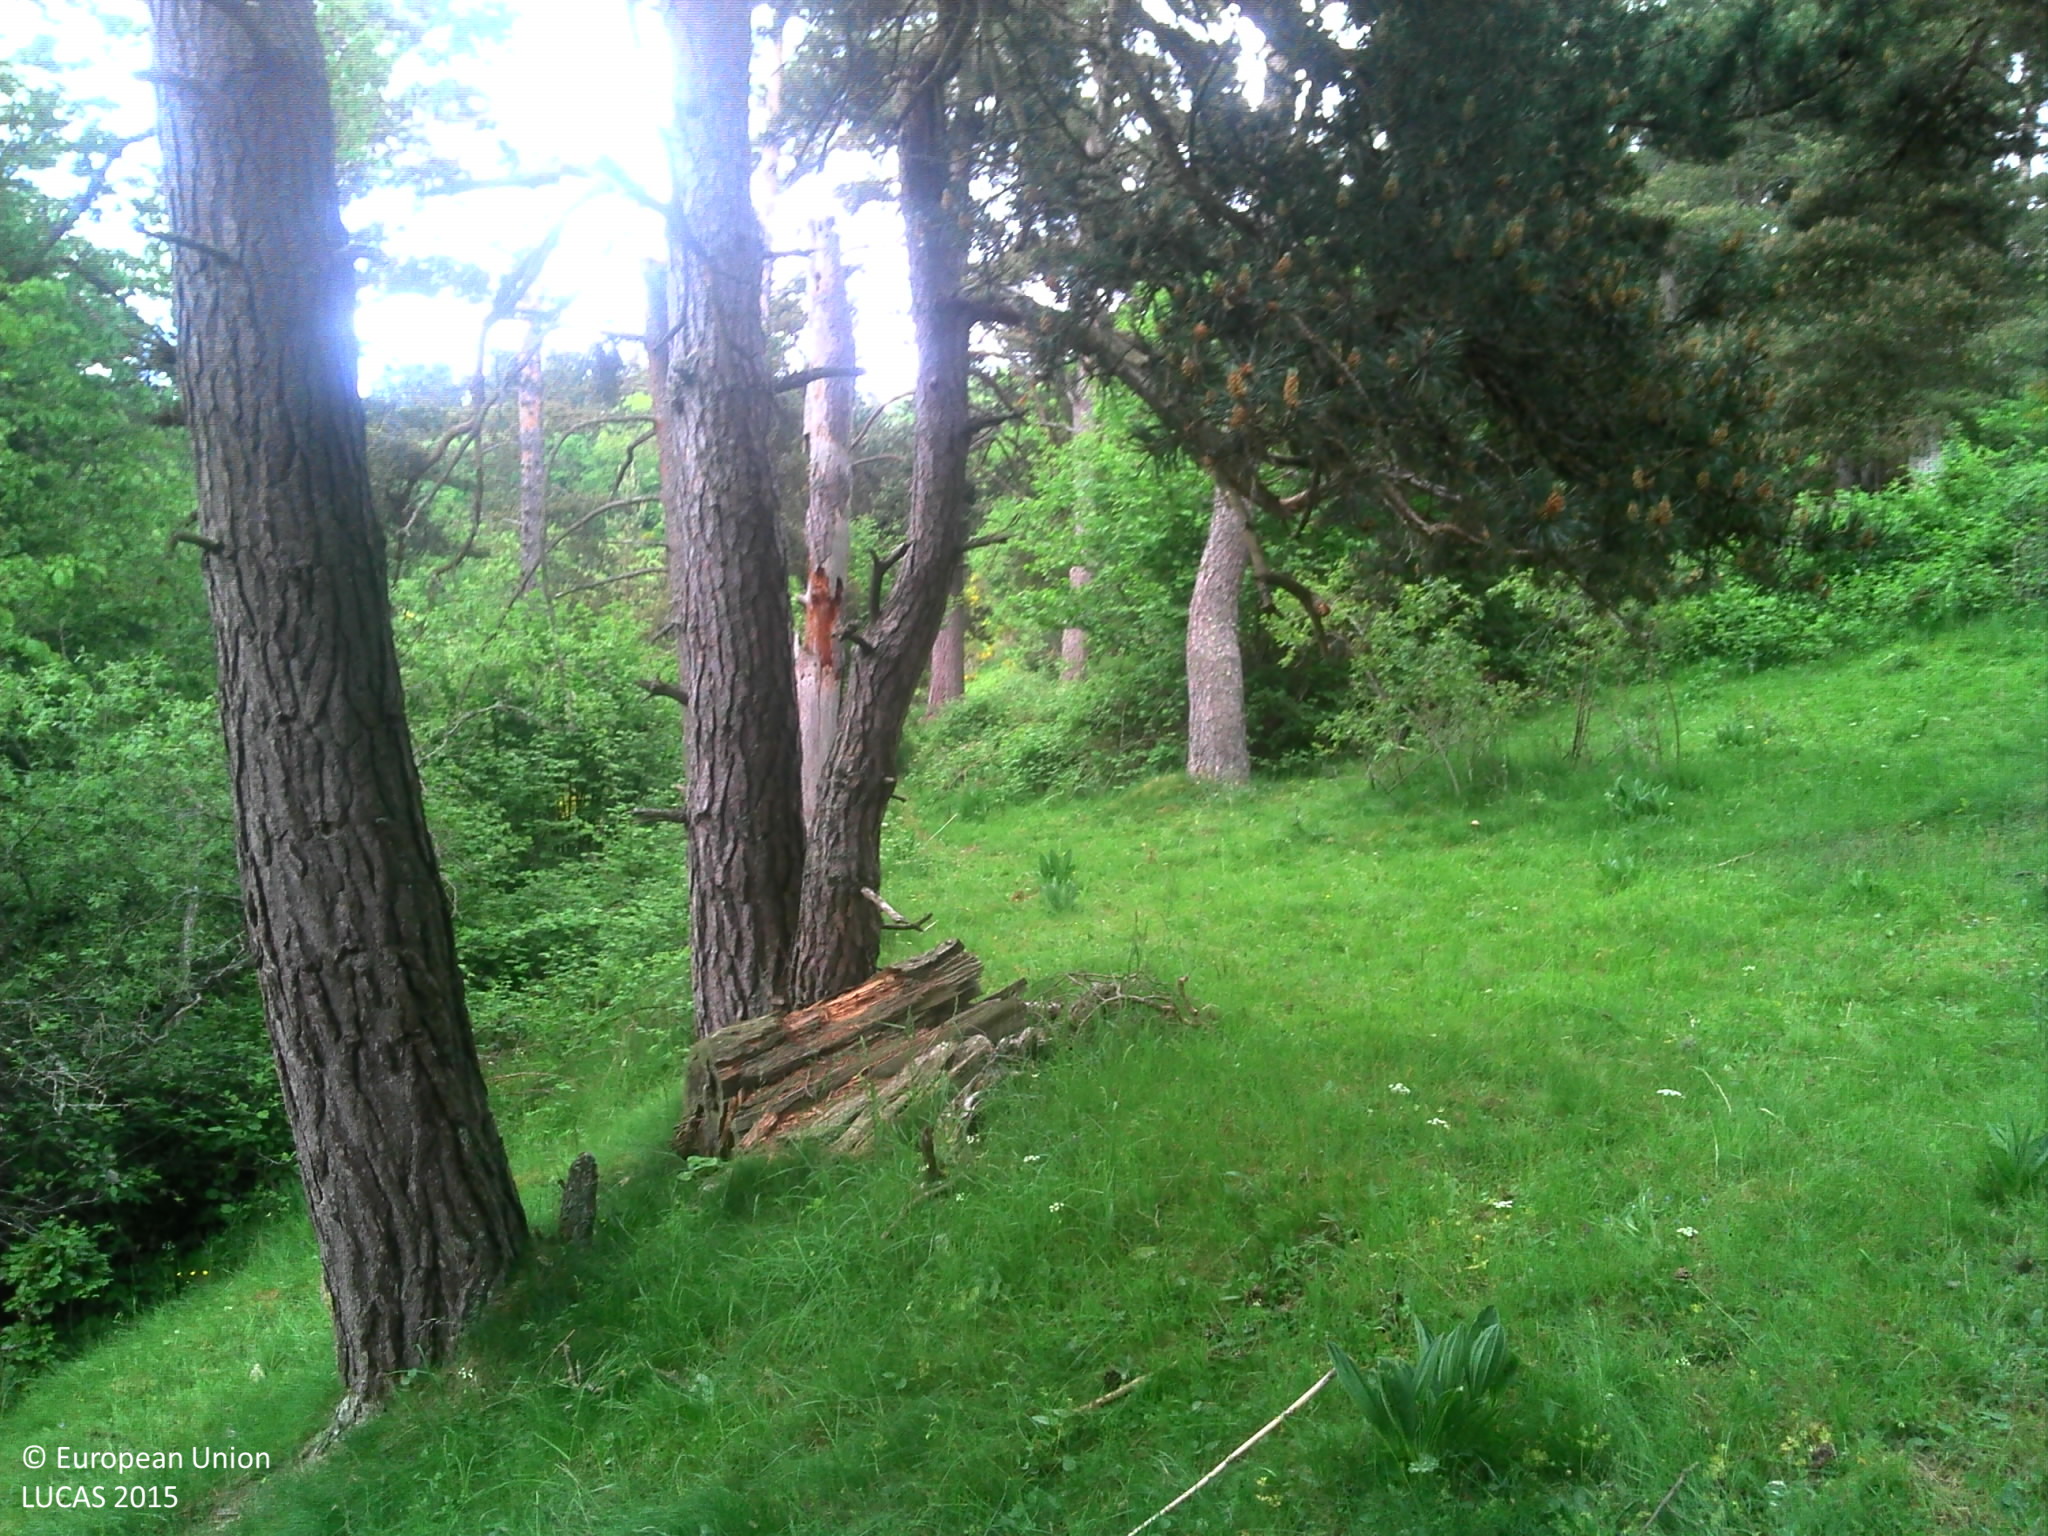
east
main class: Woodland
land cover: Pine dominated mixed woodland
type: alpine coniferous forest
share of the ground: > 75 %
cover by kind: coniferous forest trees 60 %, broadleaved forest trees 20 %, shrubs 10 %, herbaceous plants 10 %
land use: Forestry
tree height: > 5 m
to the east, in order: Pine dominated mixed woodland; Tracks; Pine dominated mixed woodland; Fences; Grass margins; Fences; Pine dominated mixed woodland; Grassland without tree/shrub cover
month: June
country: FR
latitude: 45.0164
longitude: 3.2393
